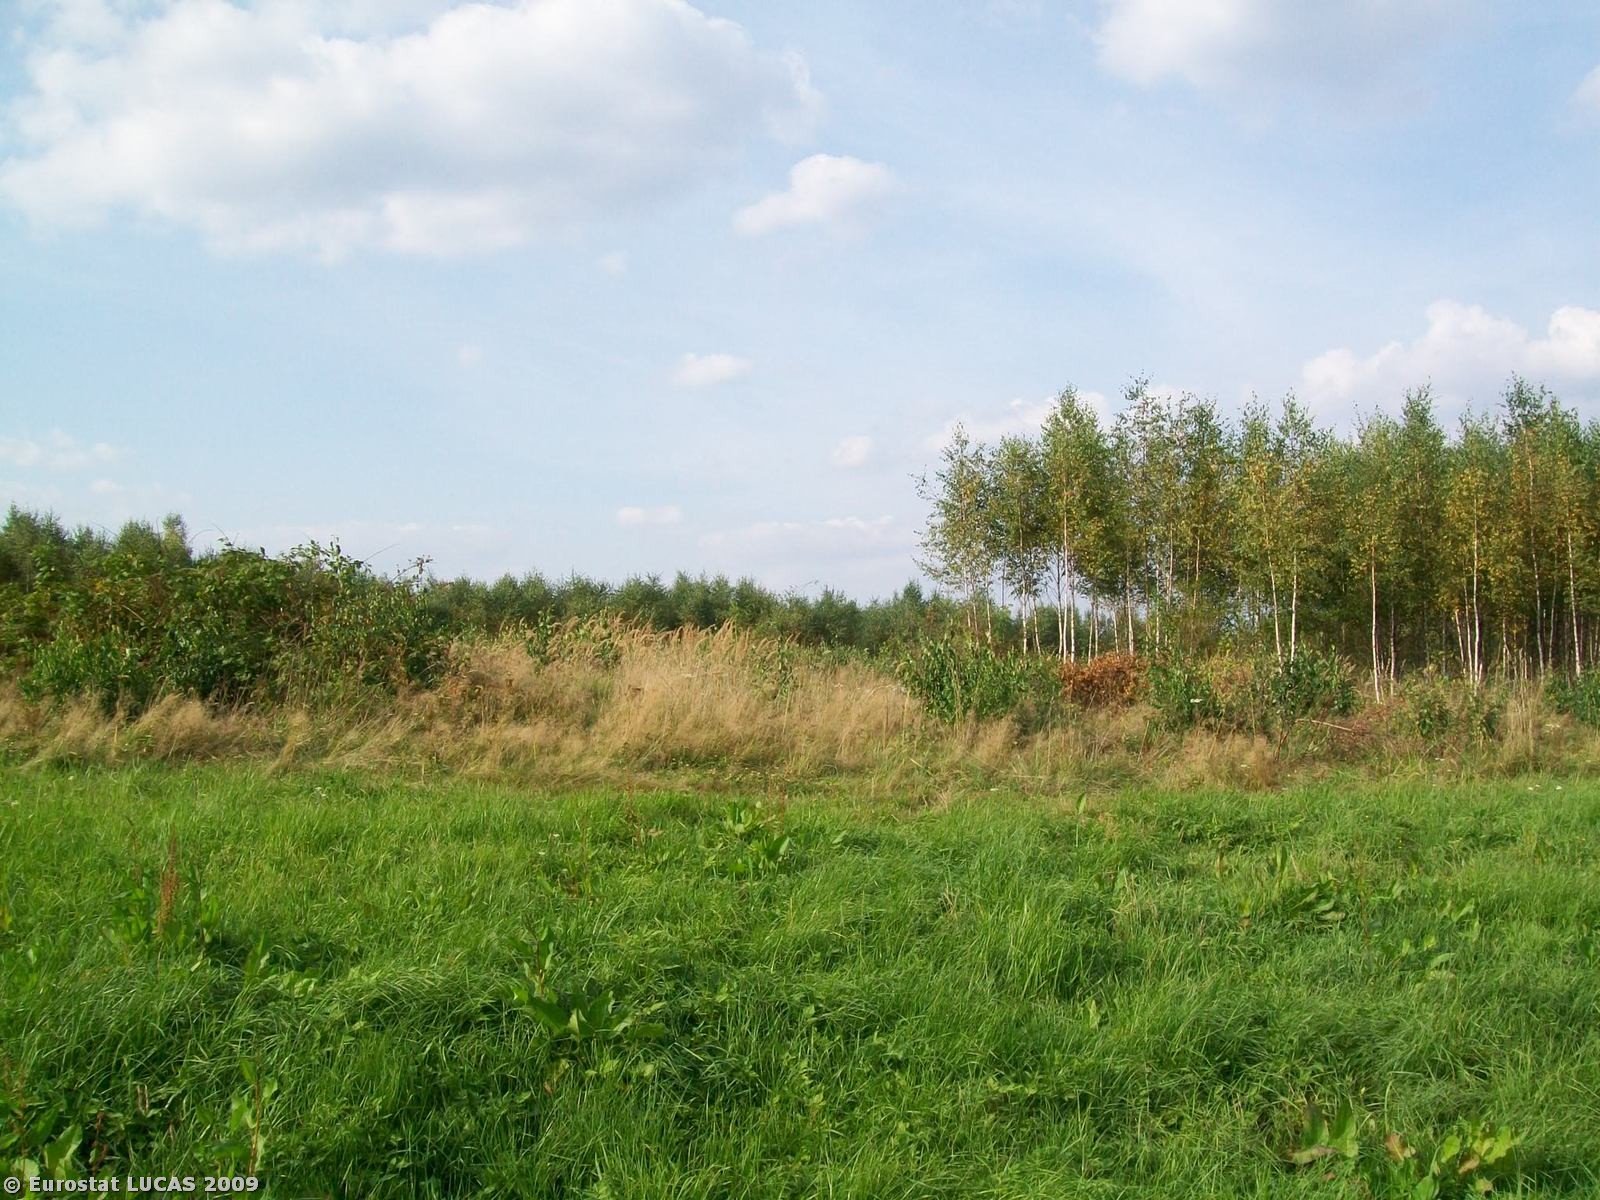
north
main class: Grassland
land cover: Grassland without tree/shrub cover
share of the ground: > 75 %
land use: Agriculture (excluding fallow land and kitchen gardens)
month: September
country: PL
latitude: 50.2269
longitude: 16.6103
